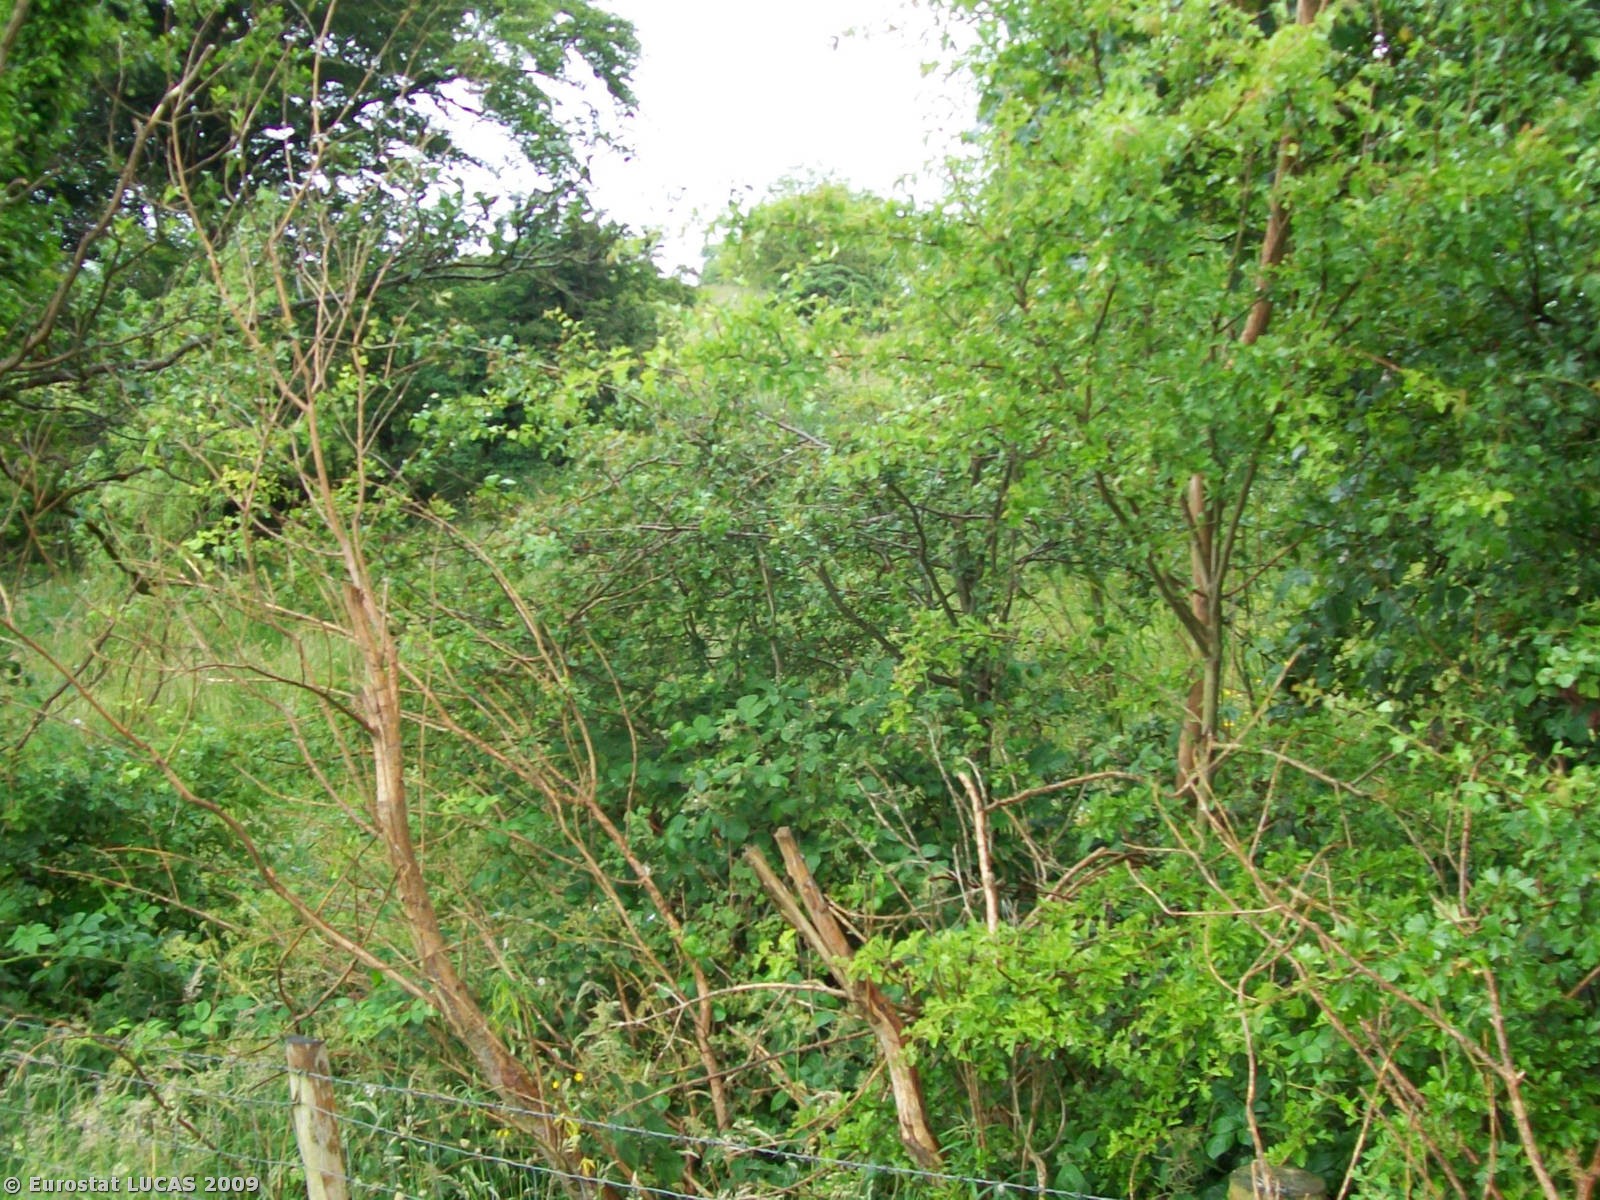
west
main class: Grassland
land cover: Grassland without tree/shrub cover
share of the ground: > 75 %
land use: Agriculture (excluding fallow land and kitchen gardens)
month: June
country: GB
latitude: 54.4830
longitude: -7.4251
